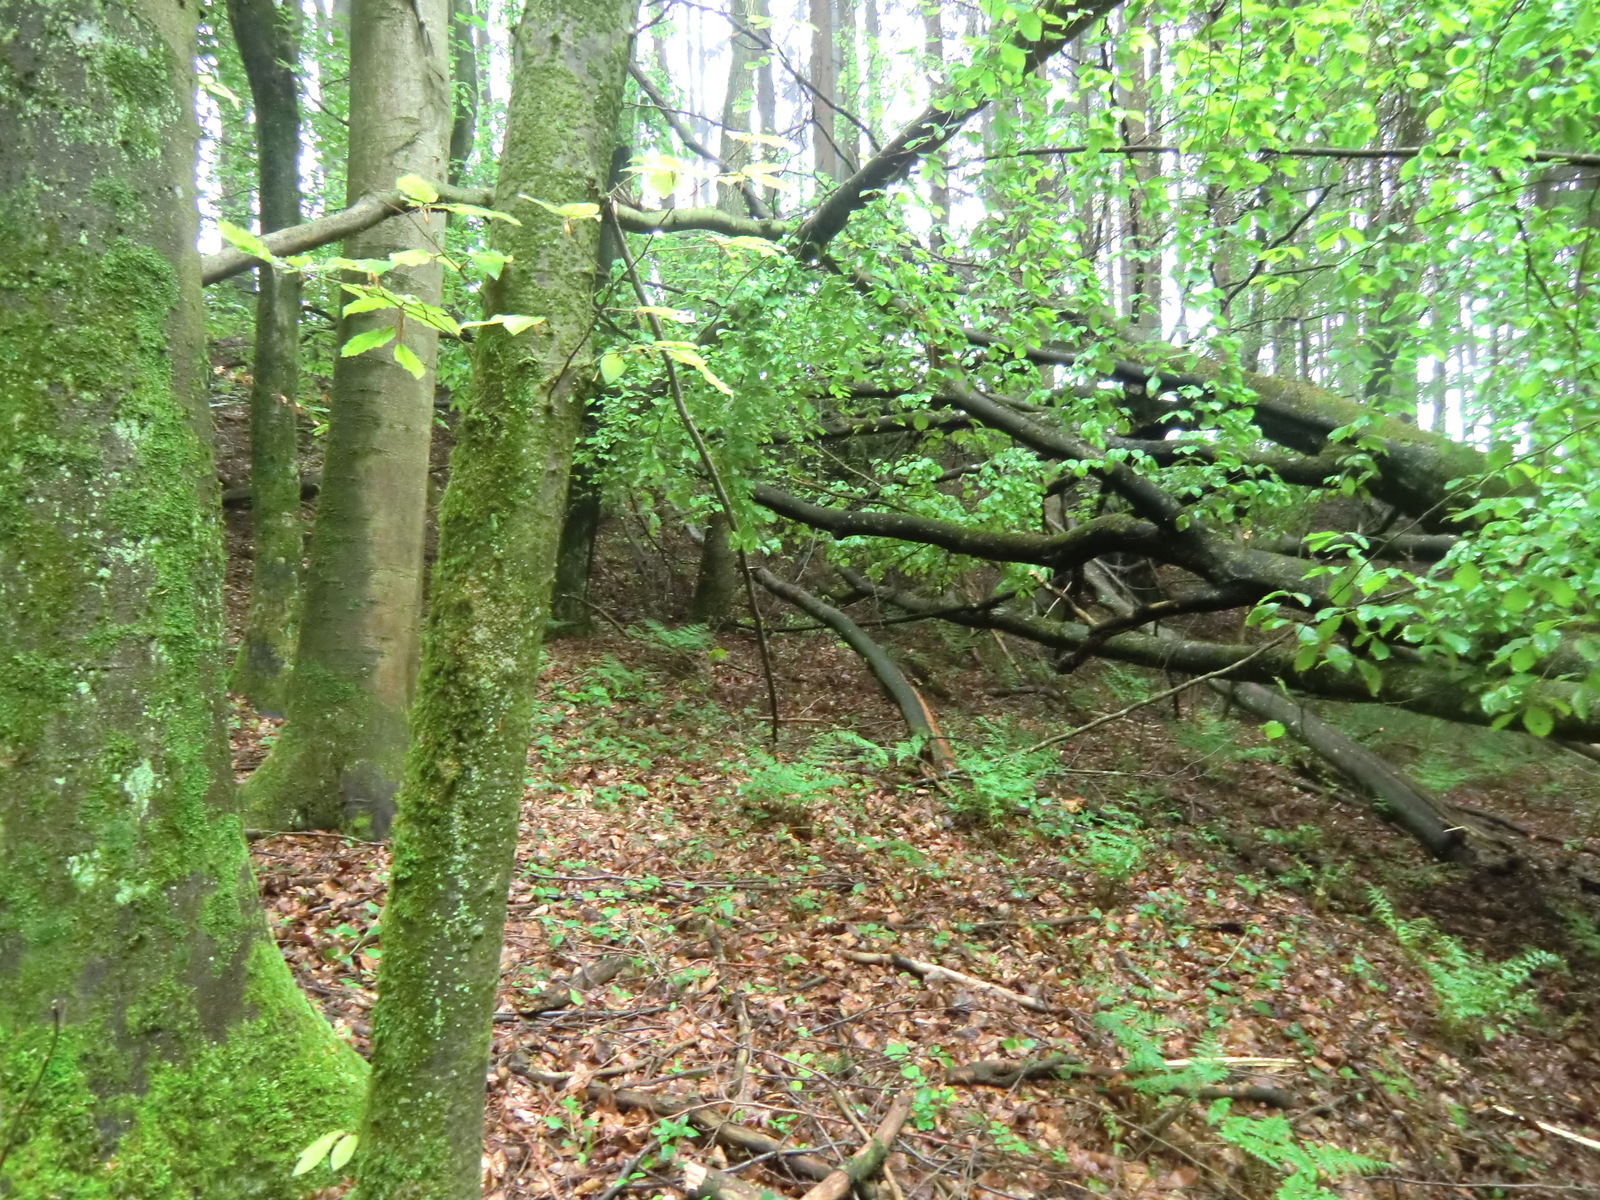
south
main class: Woodland
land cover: Broadleaved woodland
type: beech forest
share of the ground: > 75 %
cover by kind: broadleaved forest trees 80 %, unconsolidated bare surface 15 %, herbaceous plants 5 %
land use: Forestry
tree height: > 5 m
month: May
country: AT
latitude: 48.2292
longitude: 14.7529
